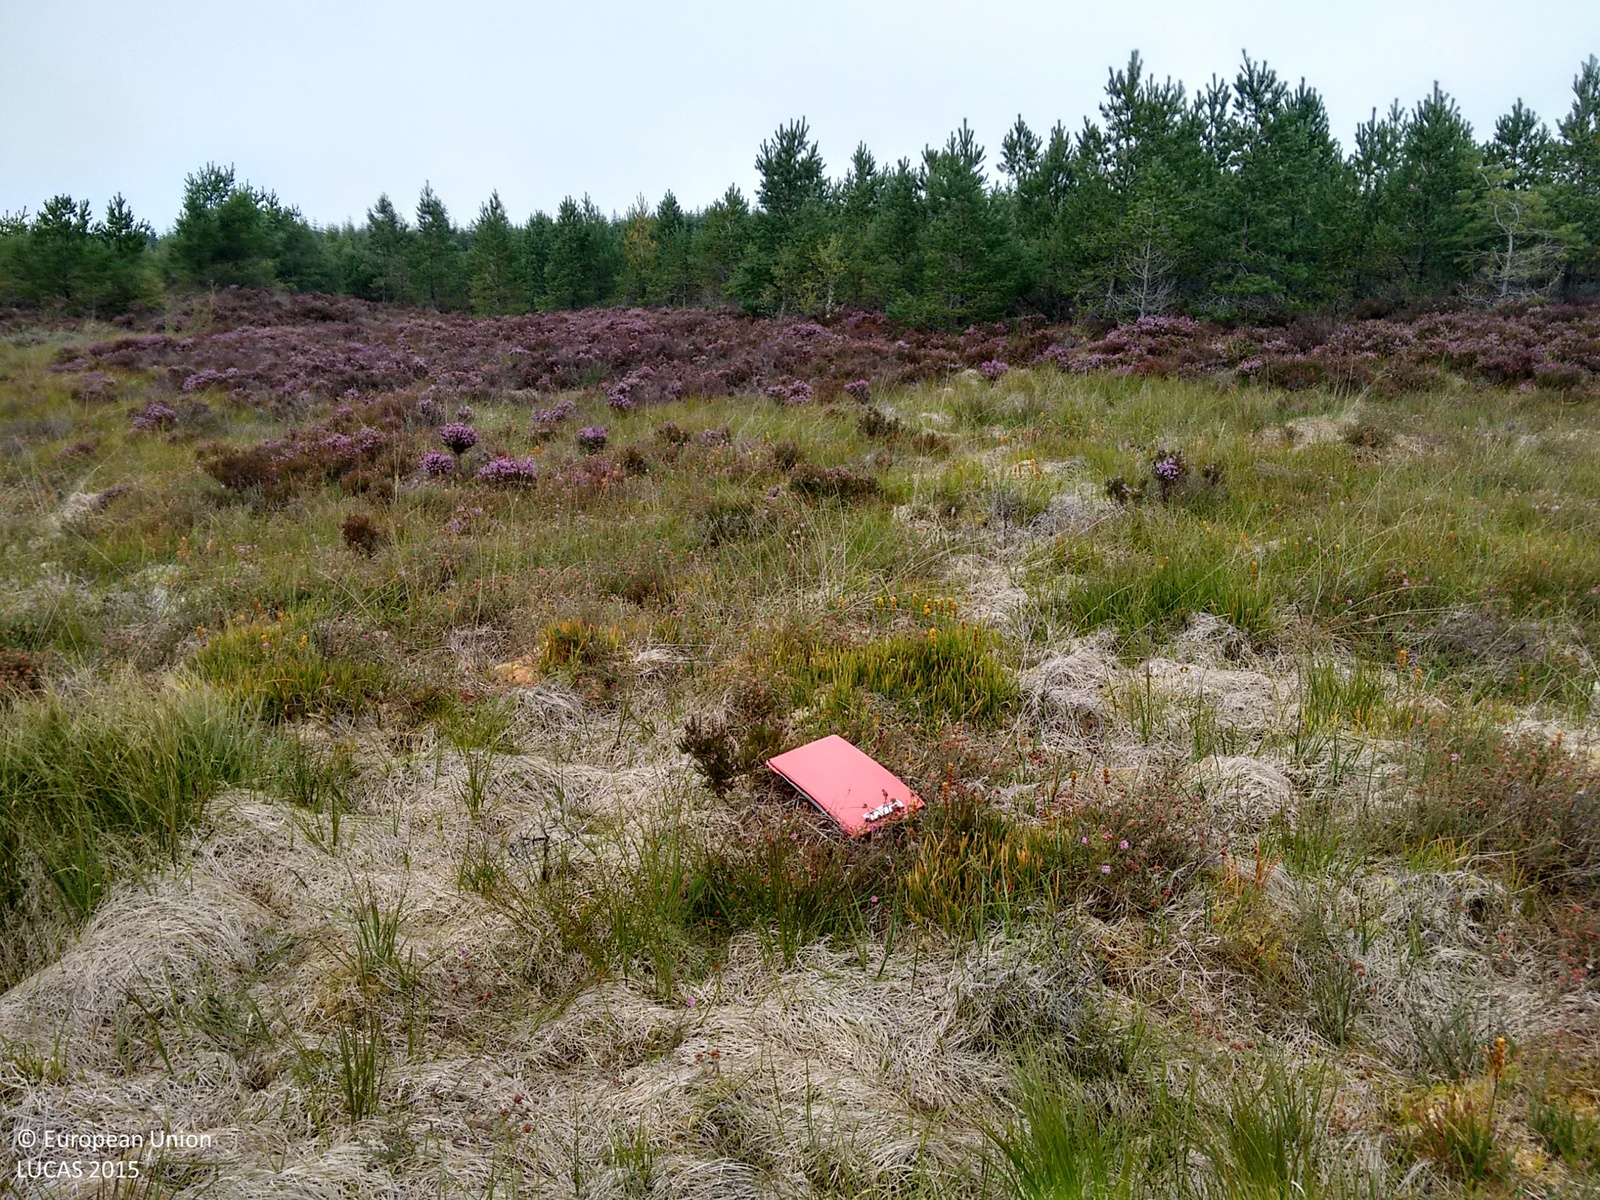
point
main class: Shrubland
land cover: Shrubland without tree cover
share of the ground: > 75 %
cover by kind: shrubs 40 %, herbaceous plants 20 %, lichens and mosses 20 %
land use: Forestry
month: September
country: GB
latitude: 58.0749
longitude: -4.1007
